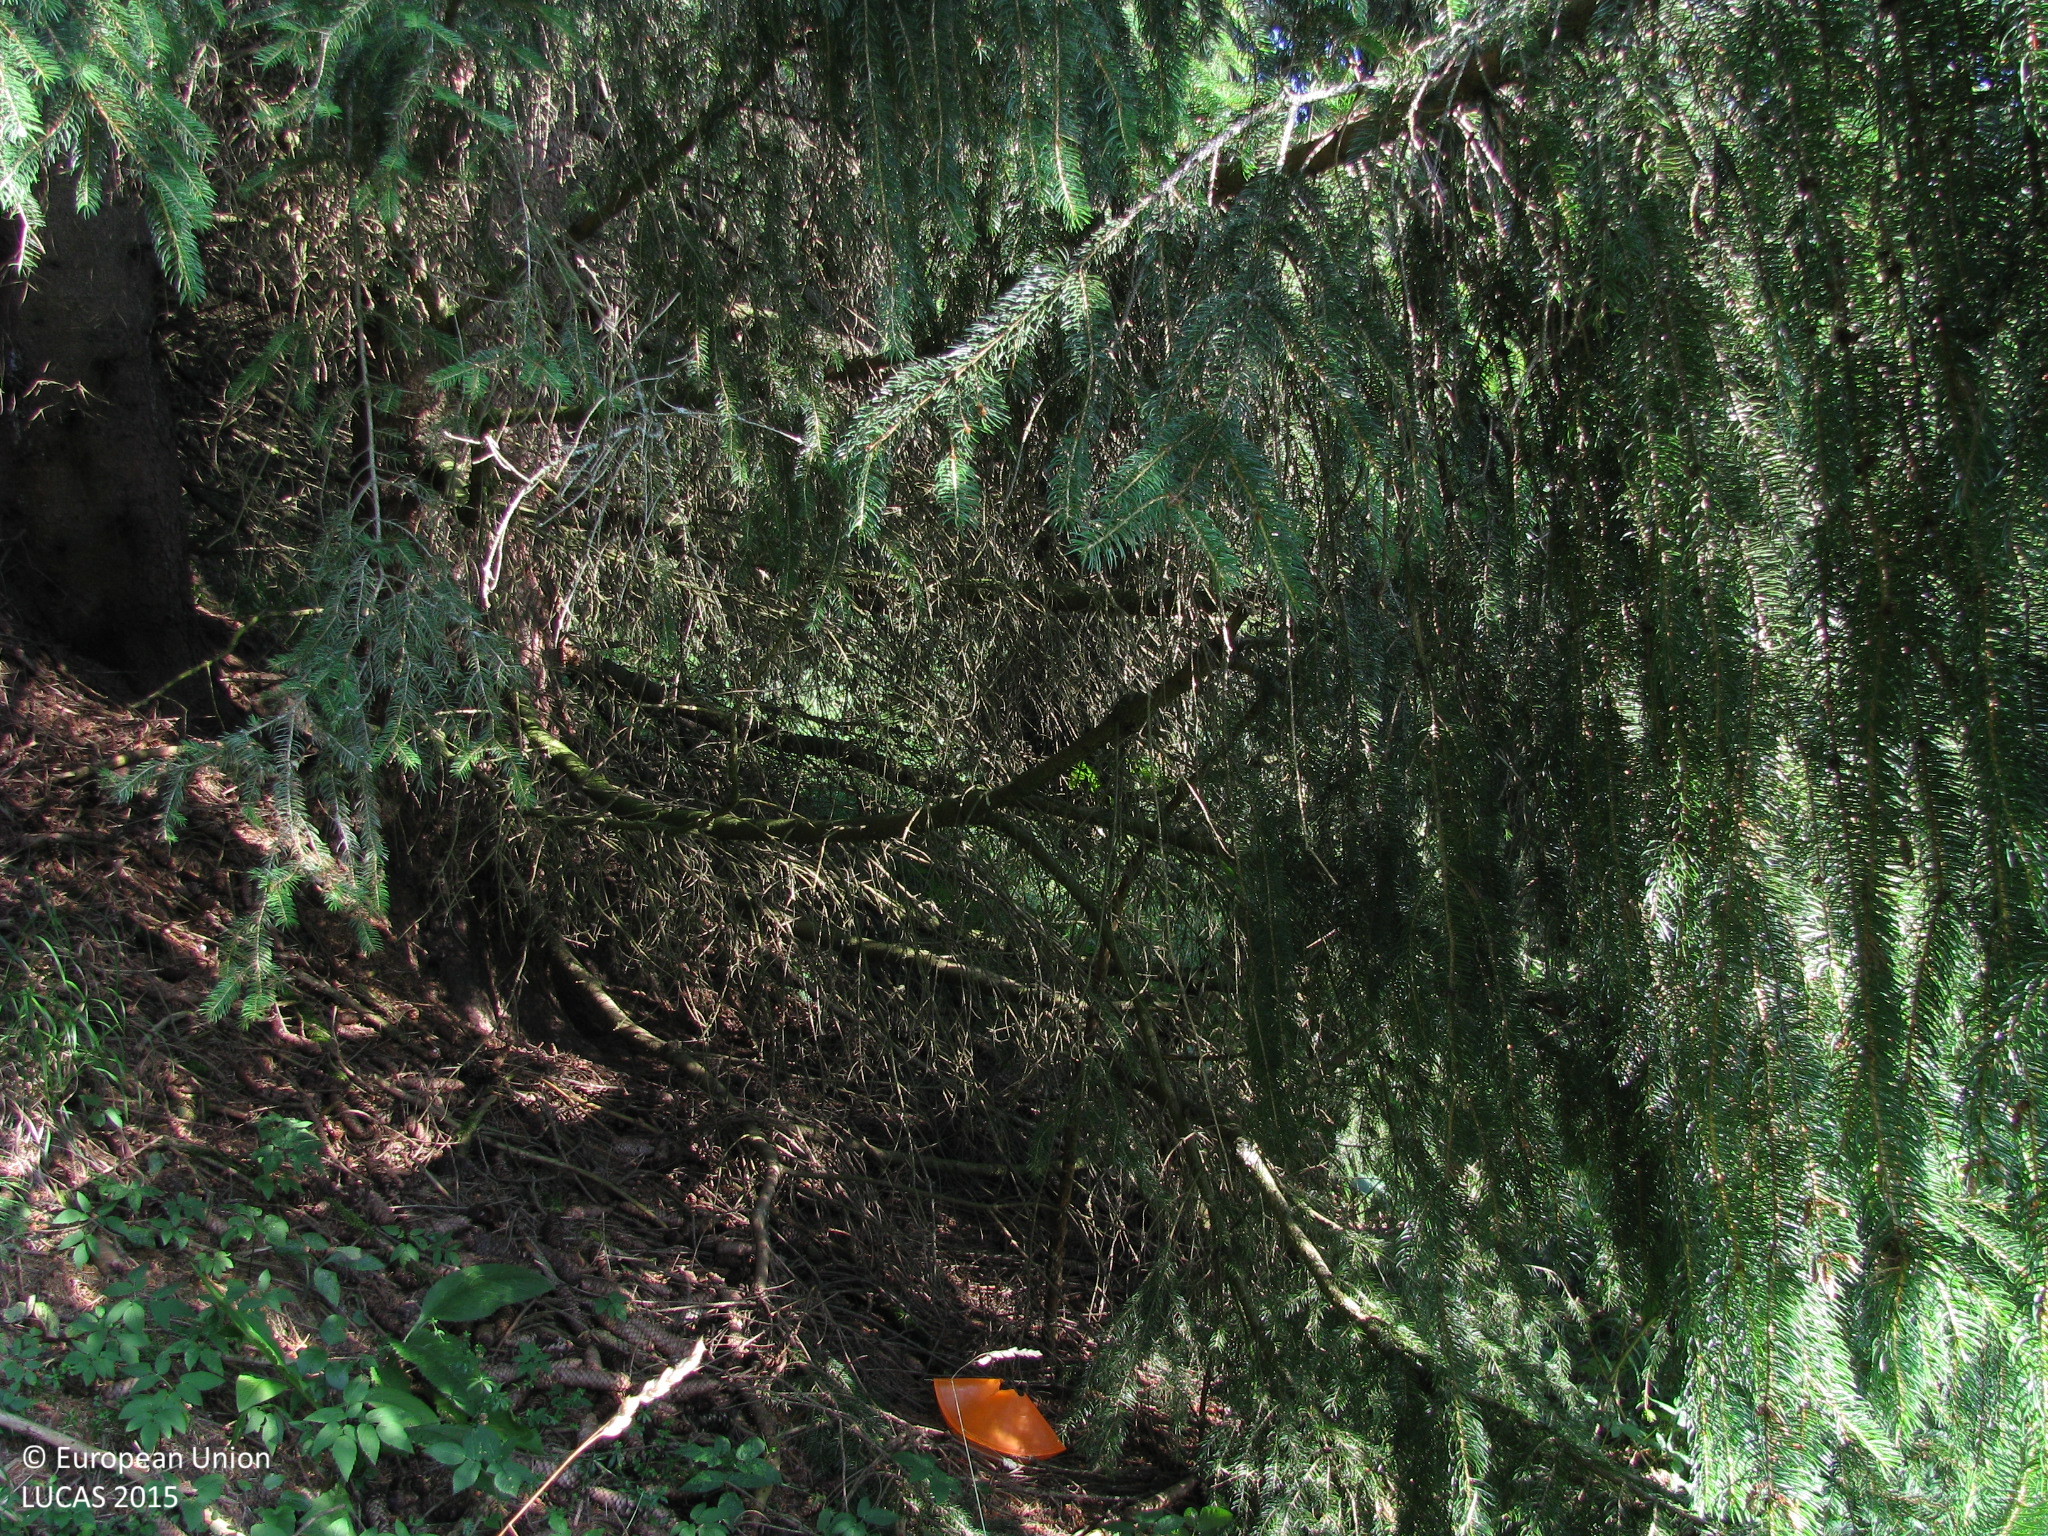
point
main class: Woodland
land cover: Spruce dominated coniferous woodland
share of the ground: > 75 %
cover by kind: coniferous forest trees 95 %, herbaceous plants 5 %
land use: Forestry
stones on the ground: < 10 %
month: July
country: AT
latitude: 47.1628
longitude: 14.8138
